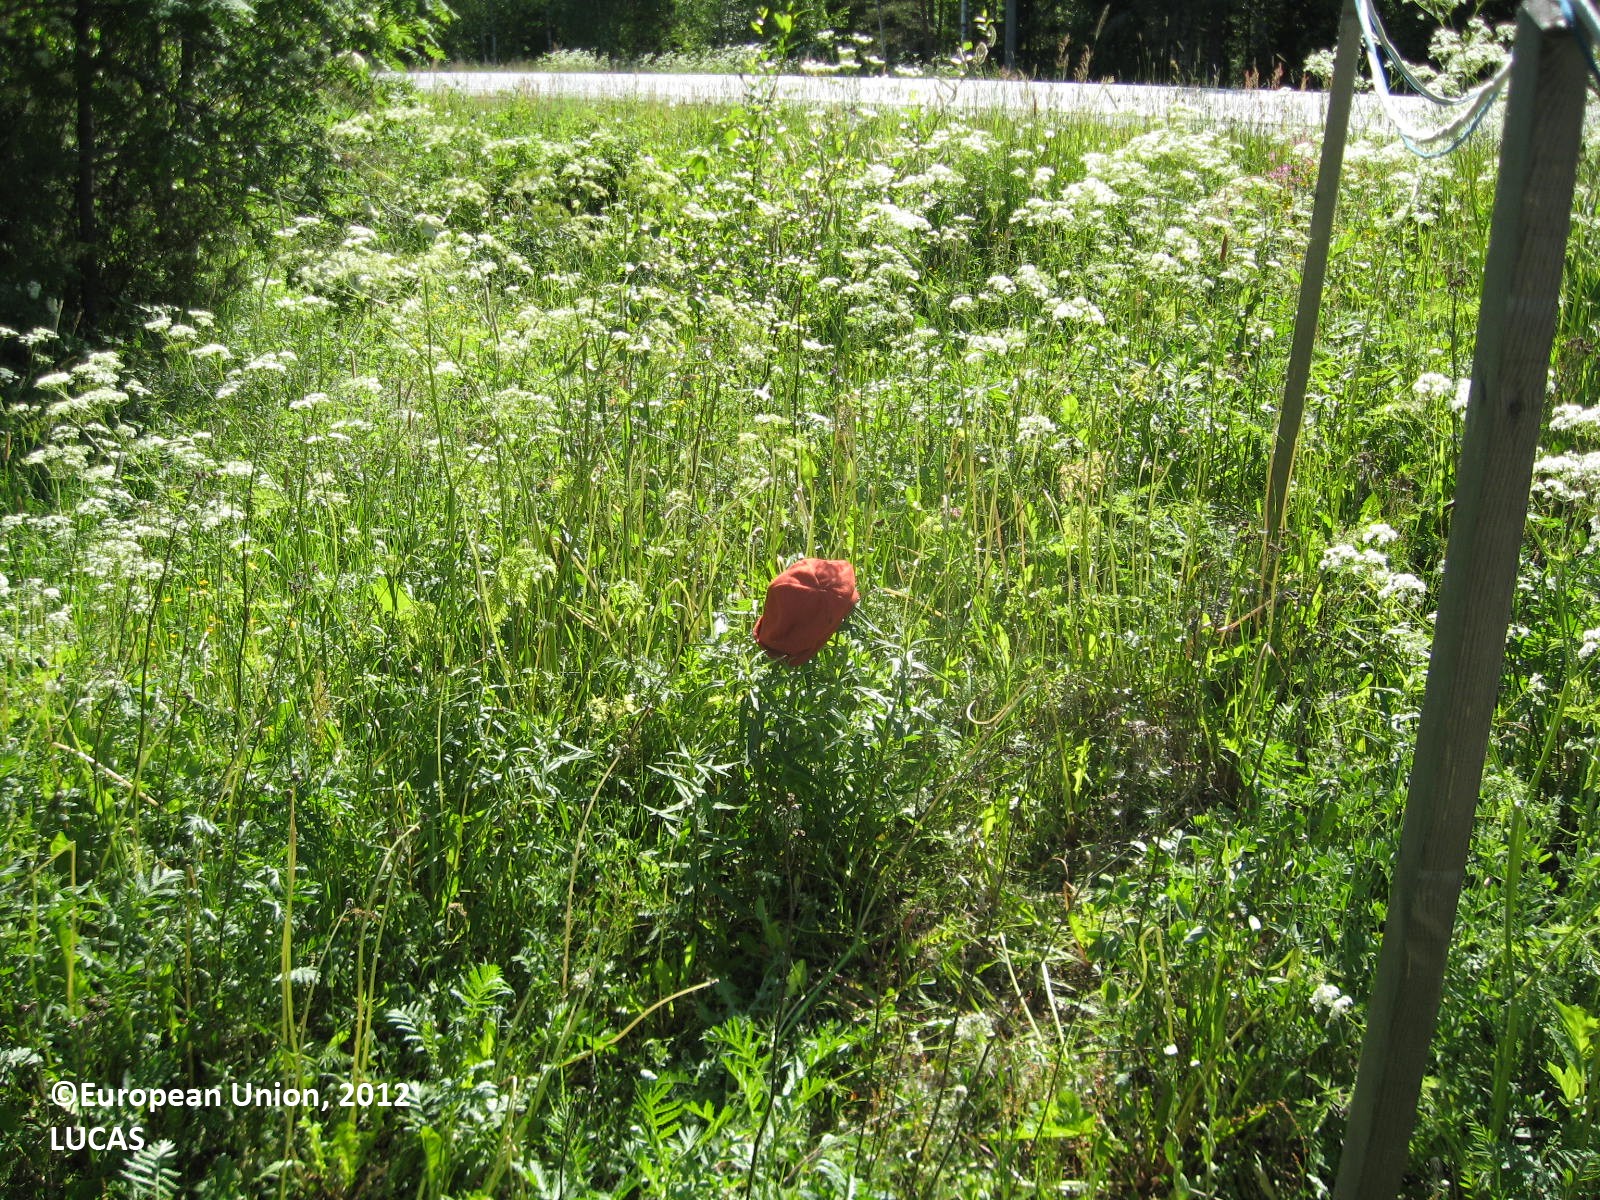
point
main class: Grassland
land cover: Grassland without tree/shrub cover
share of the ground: 10 - 25 %
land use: Agriculture (excluding fallow land and kitchen gardens)
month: June
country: FI
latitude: 62.7785
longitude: 21.6631
